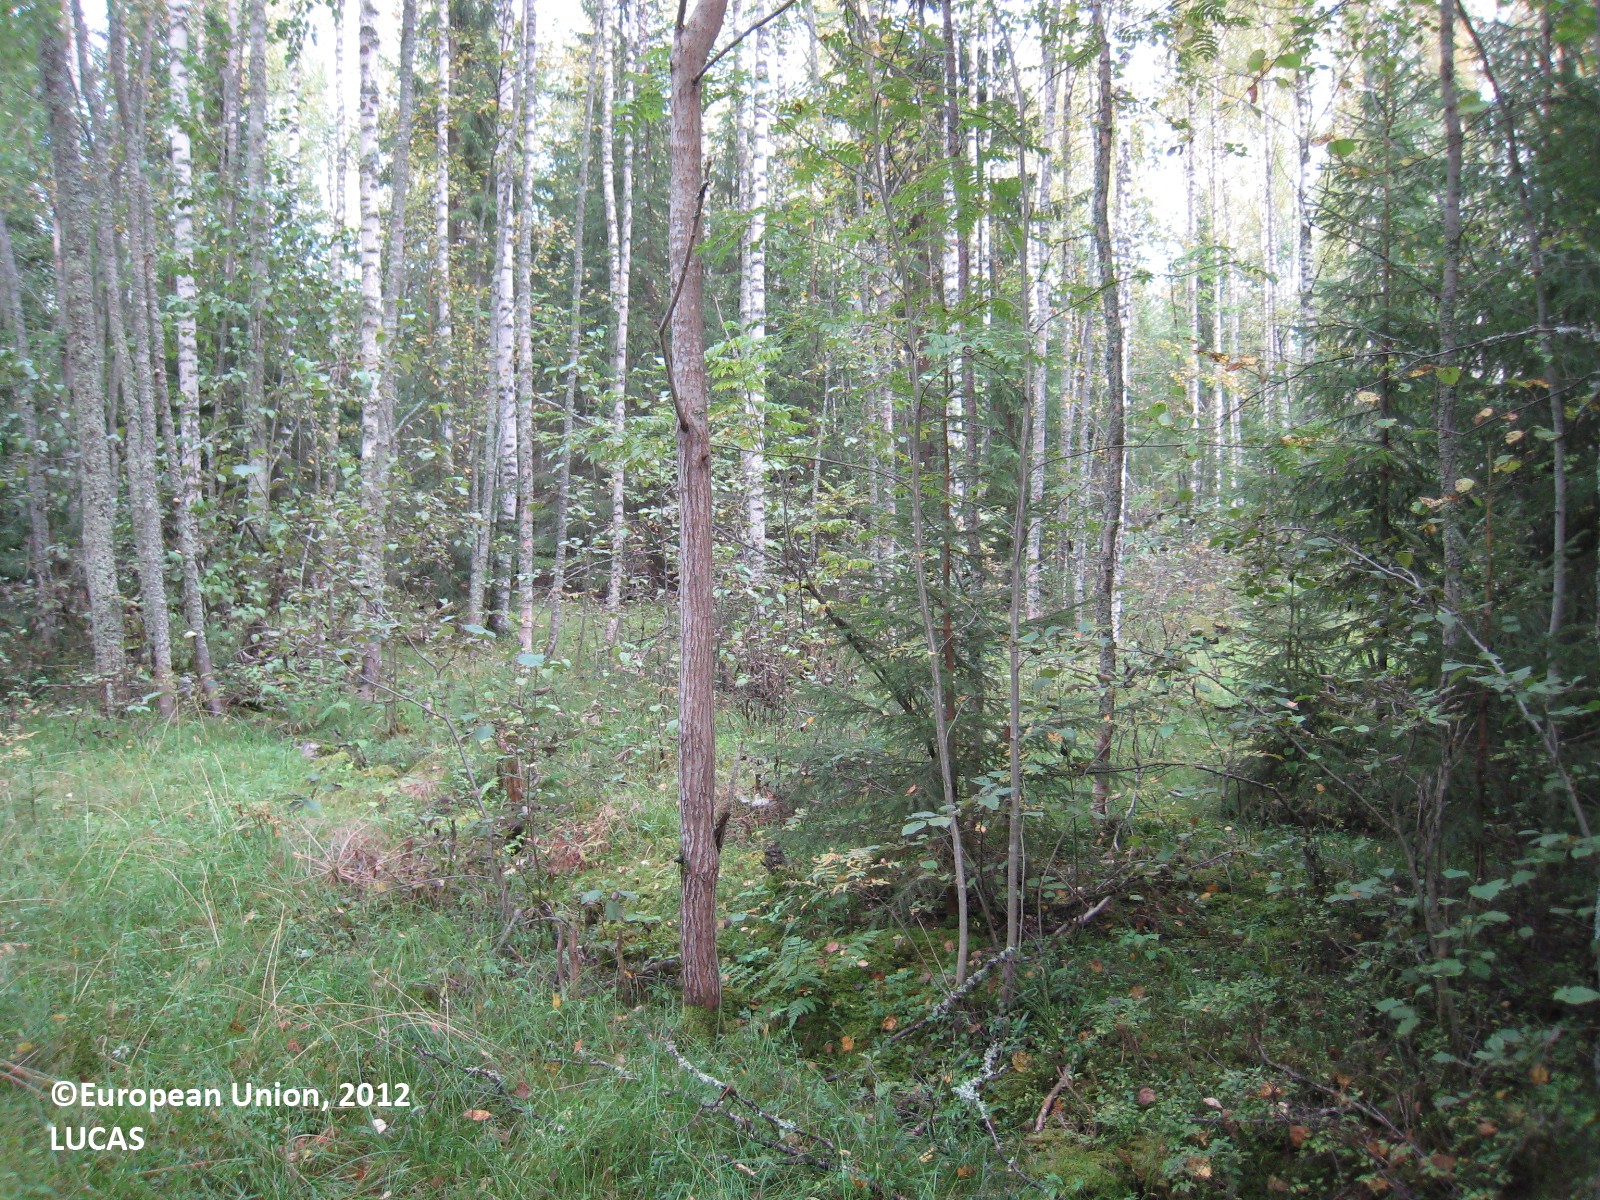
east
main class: Woodland
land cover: Spruce dominated mixed woodland
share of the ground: > 75 %
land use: Forestry
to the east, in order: Spruce dominated mixed woodland; Electric lines; Spruce dominated mixed woodland; Other mixed woodland; Spruce dominated mixed woodland; Dry stone walls; Shruby margins; Tracks; Other coniferous woodland; Spruce dominated coniferous woodland; Spruce dominated mixed woodland
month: September
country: FI
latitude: 62.9541
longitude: 26.6361
